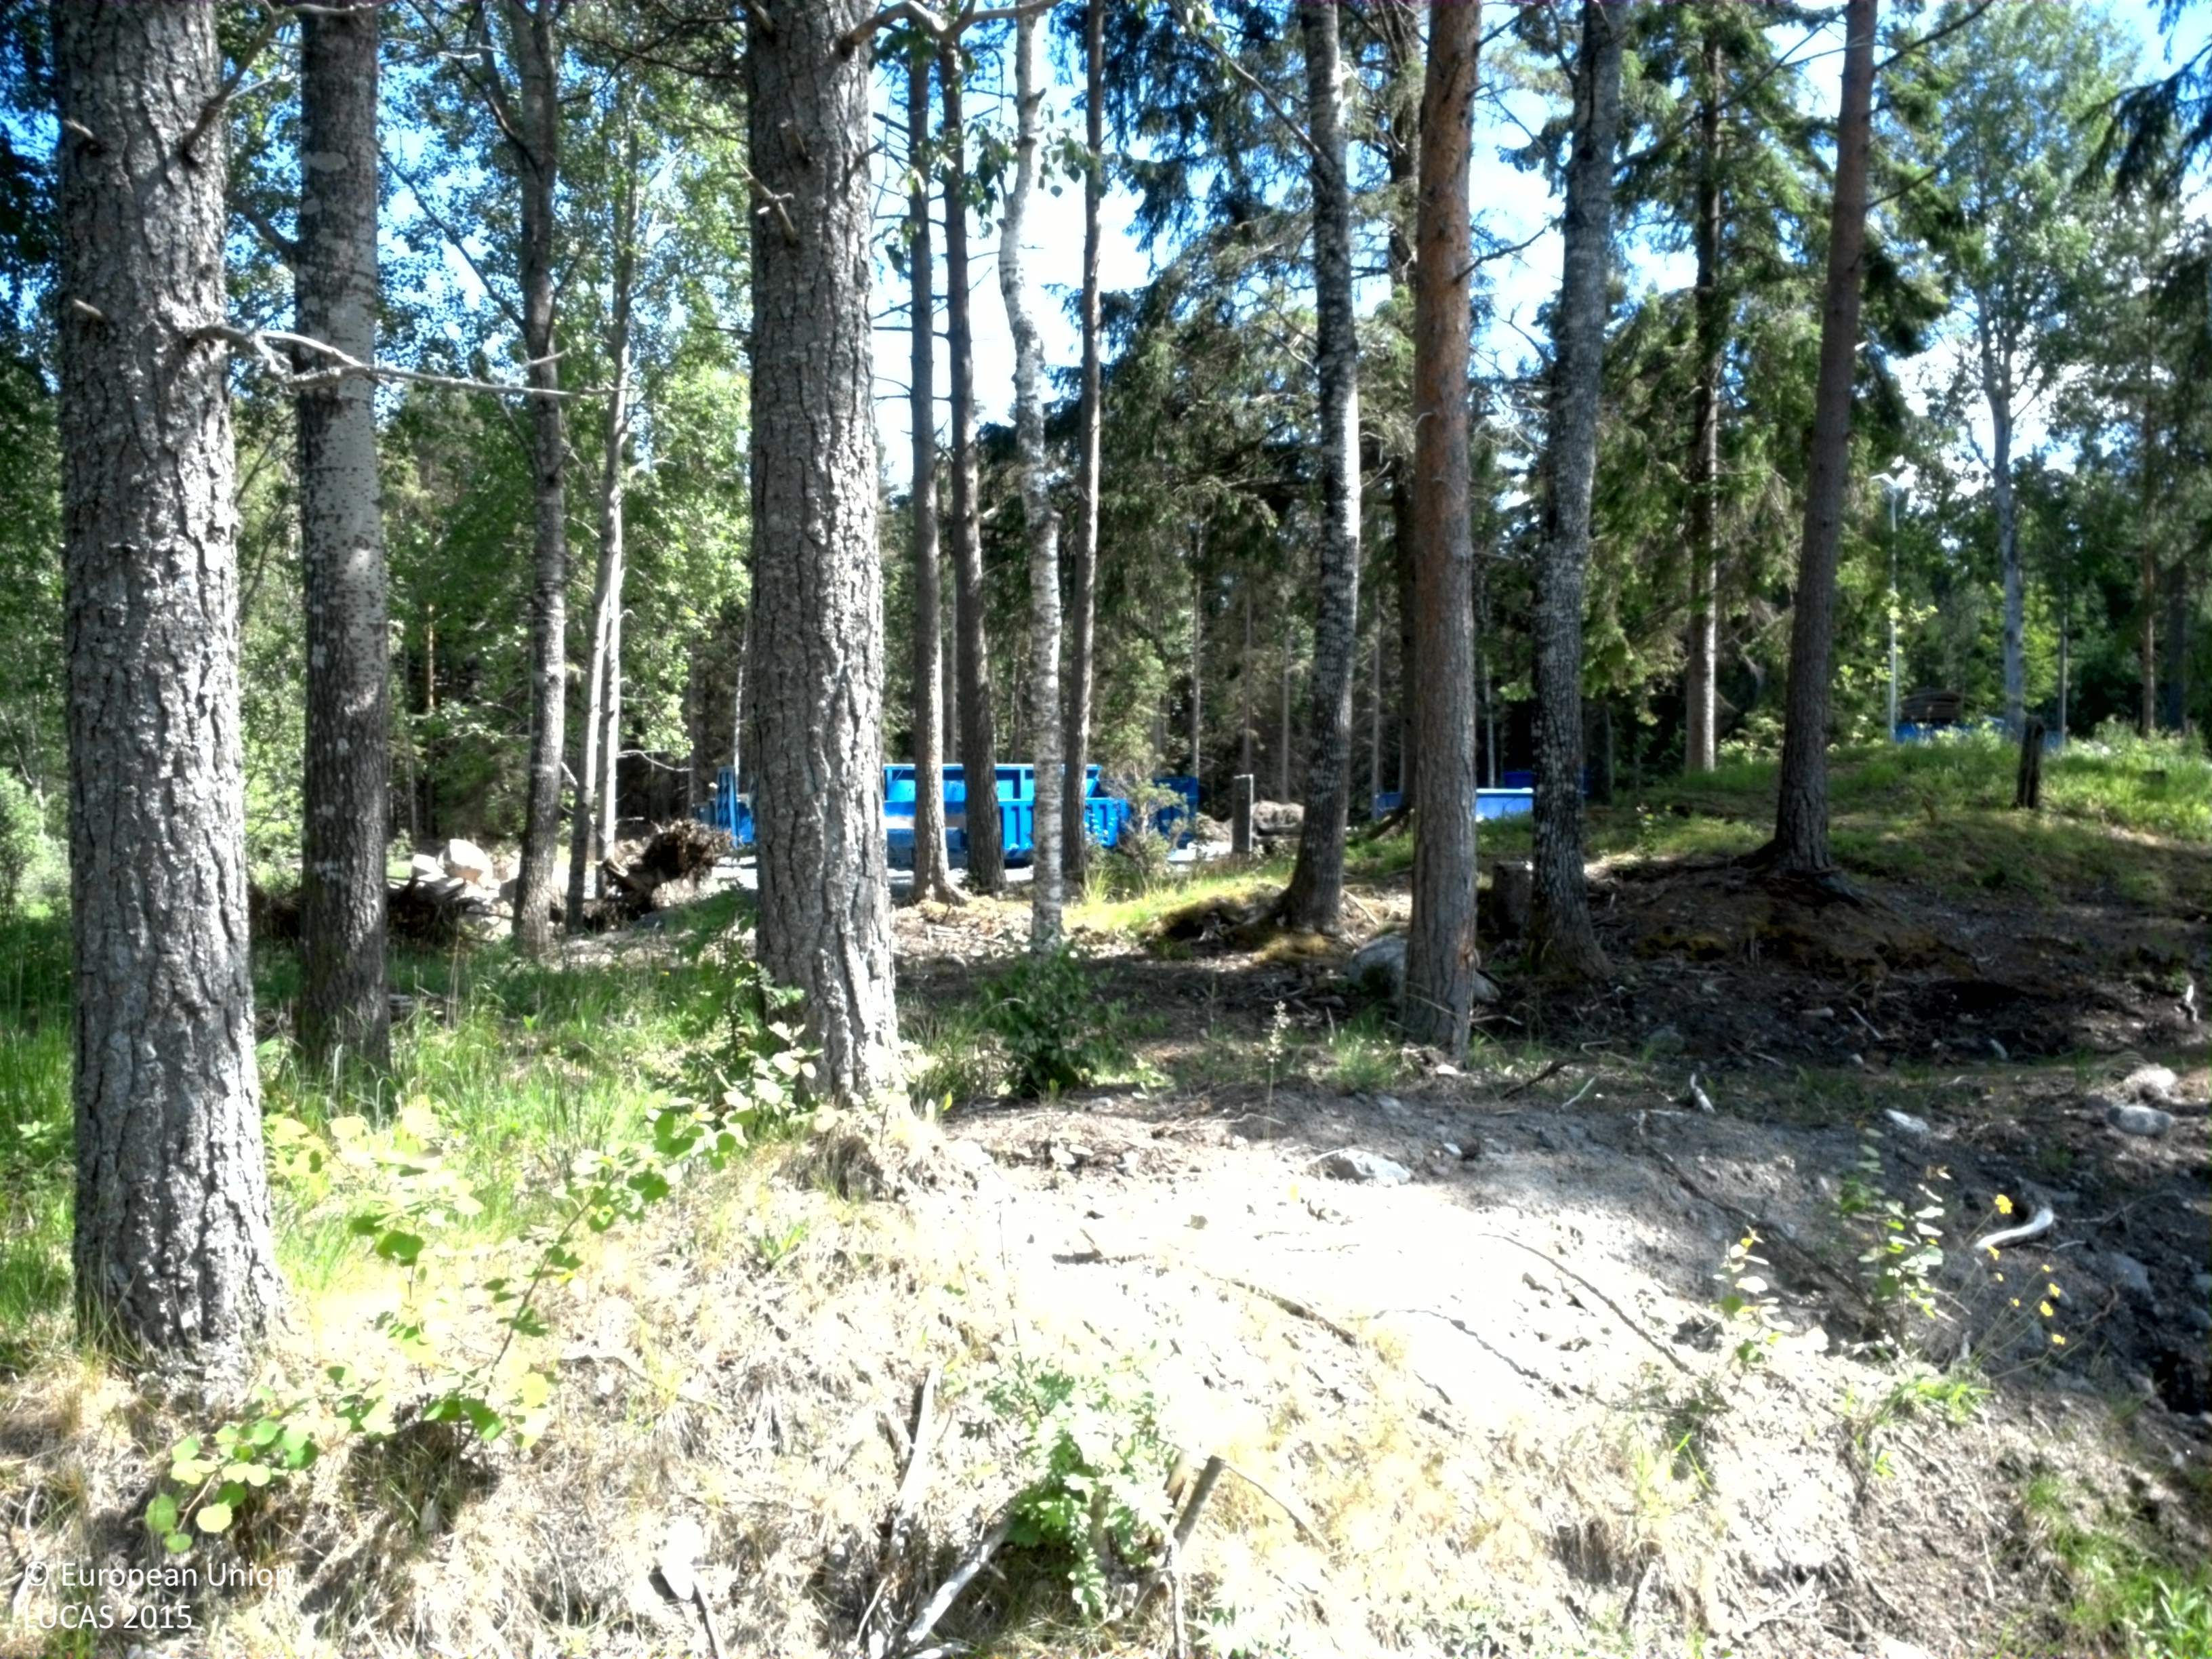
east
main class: Grassland
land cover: Grassland without tree/shrub cover
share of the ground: 25 - 50 %
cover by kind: unconsolidated bare surface 60 %, herbaceous plants 40 %
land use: Semi-natural and natural areas not in use
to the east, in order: Grassland without tree/shrub cover; Ditches and canals; Pine dominated coniferous woodland; Artificial constructions in urban areas; Spruce dominated coniferous woodland; Grass margins; Paved roads, cycling and walking lanes; Grass margins; Pine dominated coniferous woodland; Spruce dominated coniferous woodland
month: June
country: SE
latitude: 60.0983
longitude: 18.6118
